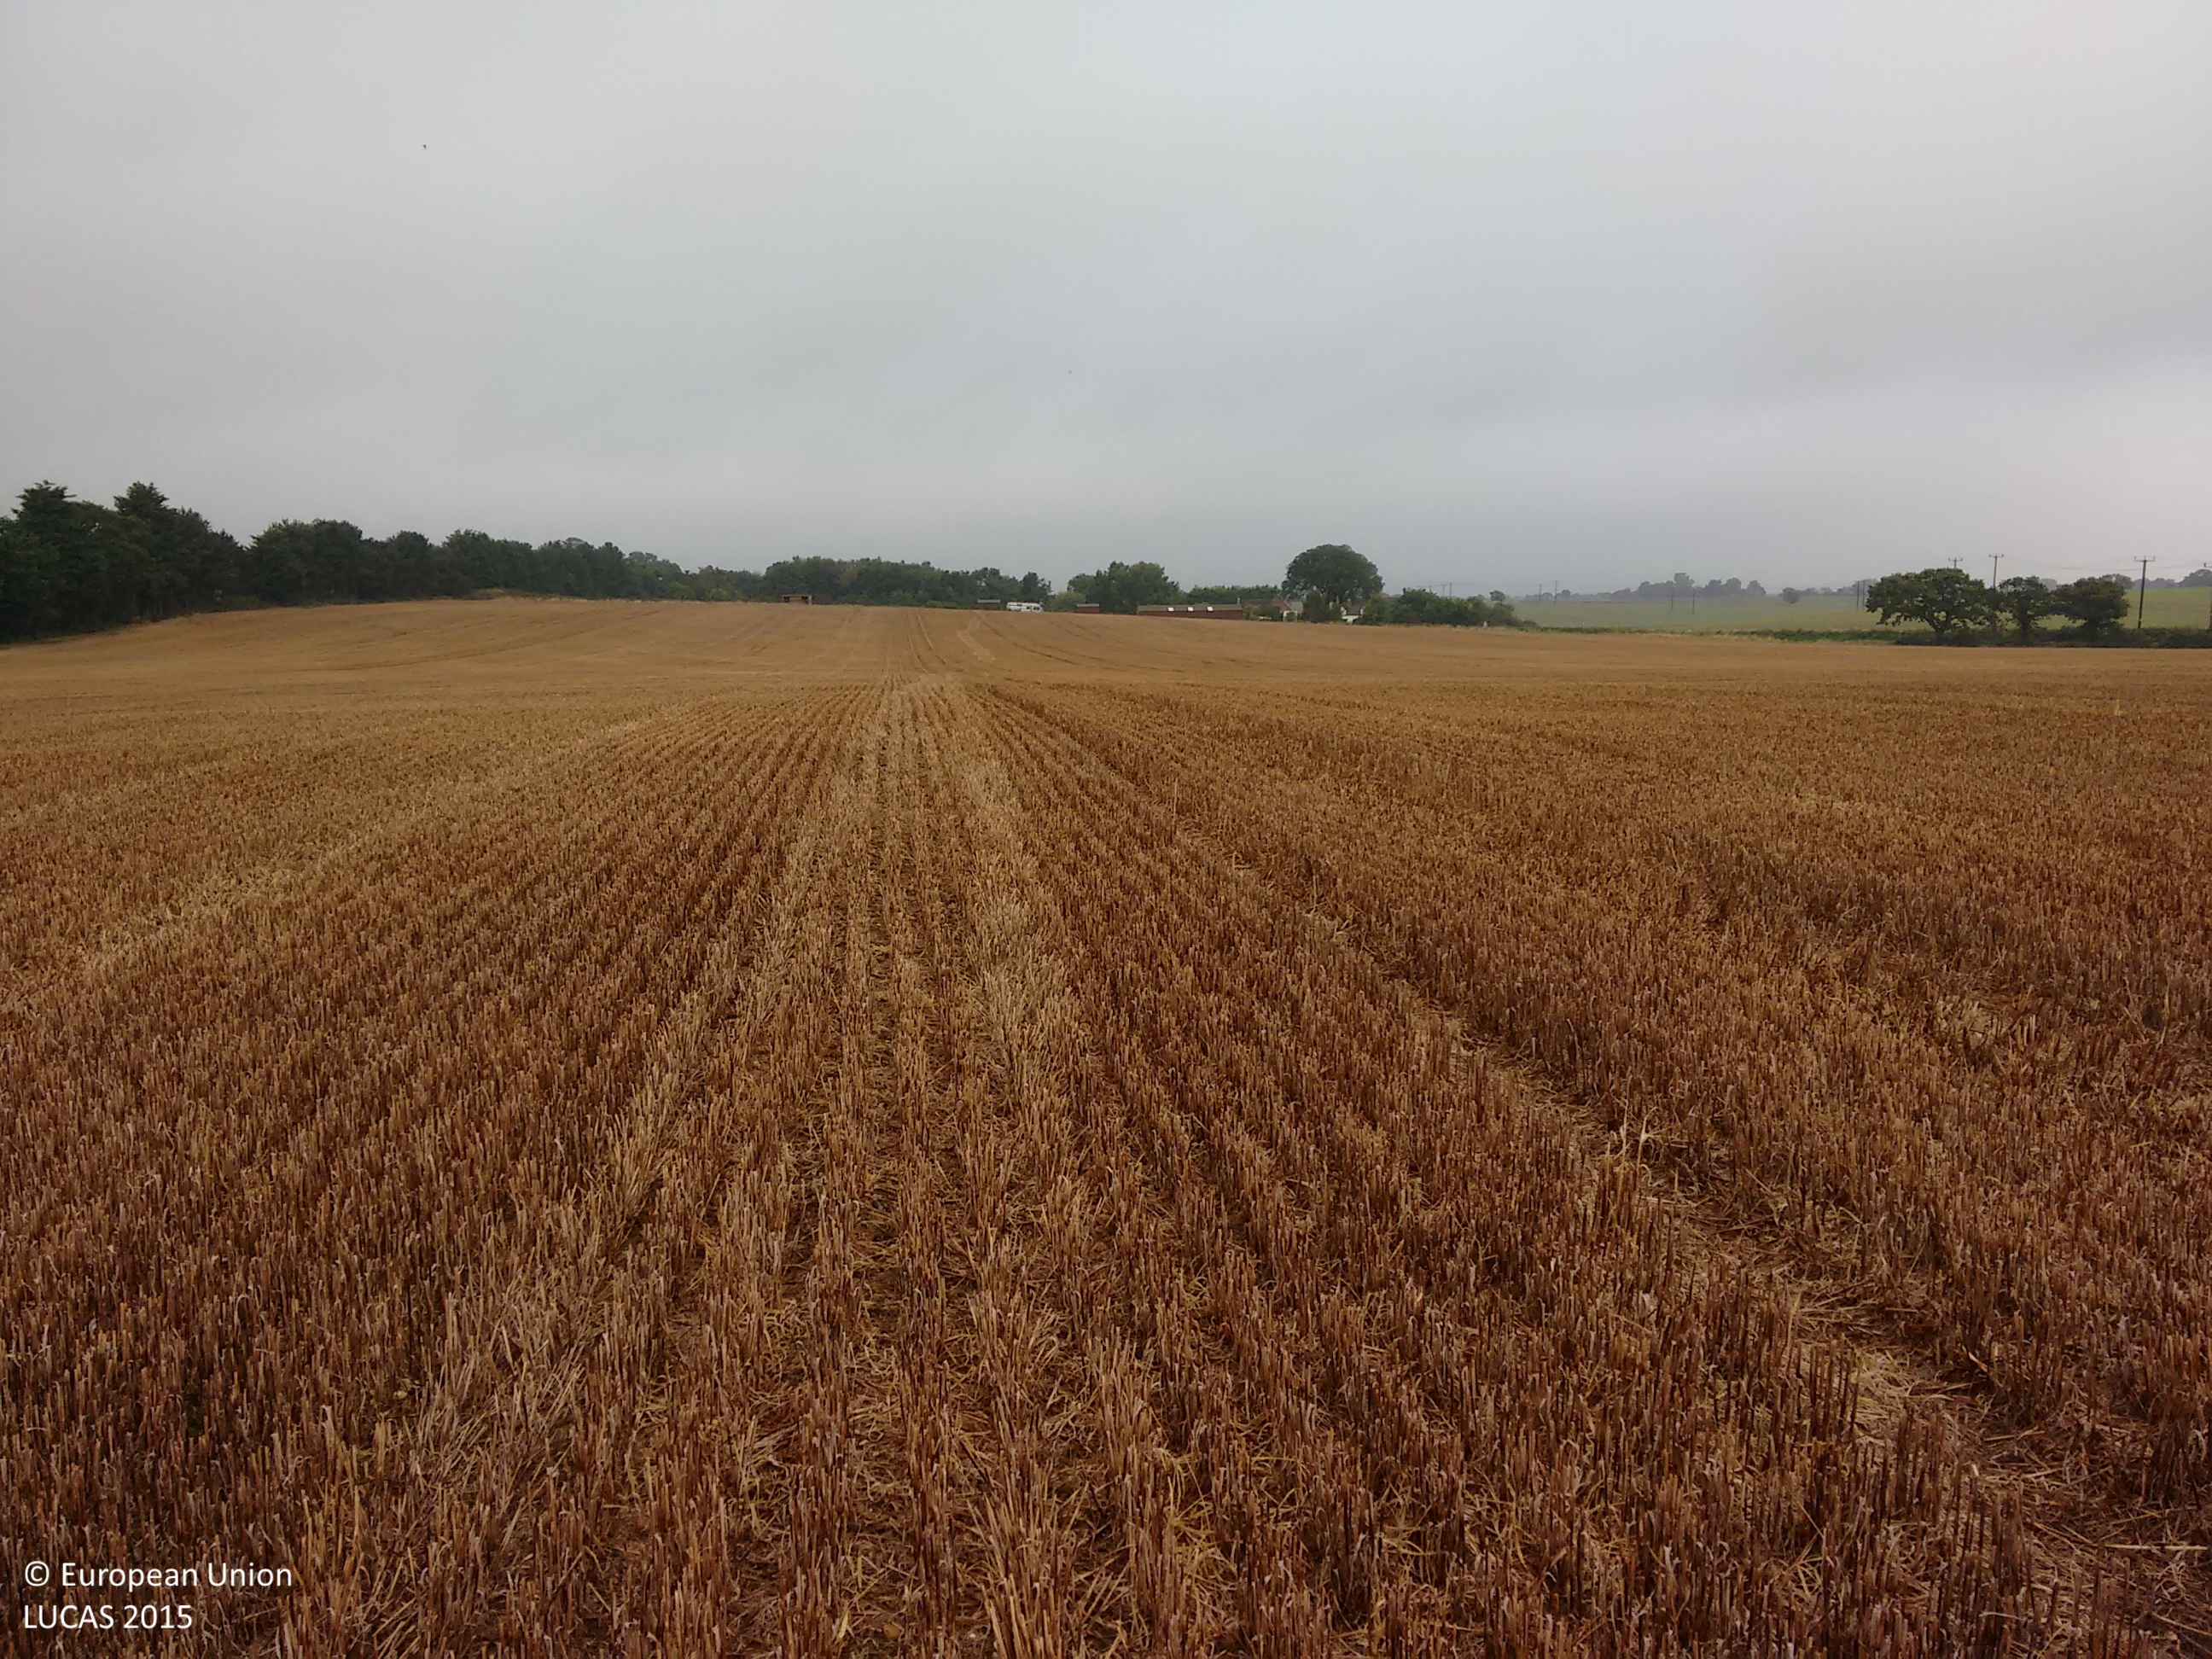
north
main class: Cropland
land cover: Common wheat
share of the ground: > 75 %
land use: Agriculture (excluding fallow land and kitchen gardens)
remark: Harvested field
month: October
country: GB
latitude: 52.5391
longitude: 1.7112
